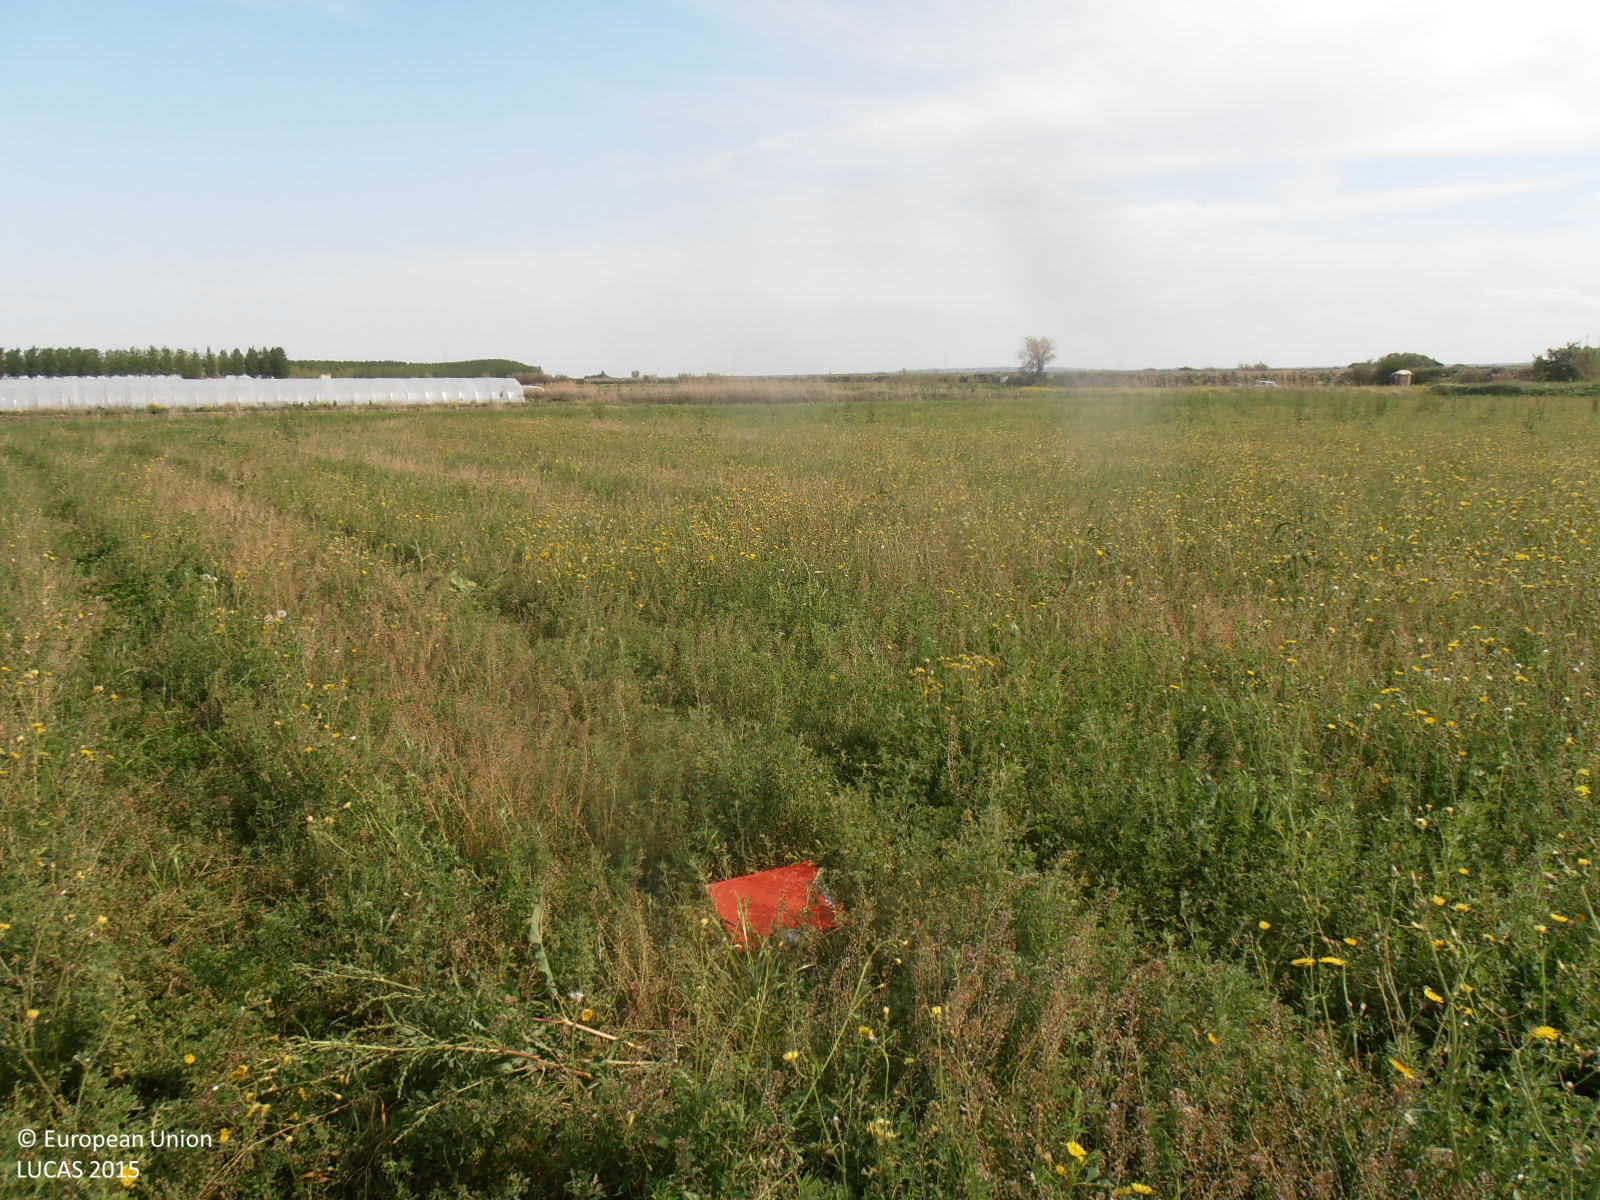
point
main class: Cropland
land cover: Lucerne
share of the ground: > 75 %
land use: Agriculture (excluding fallow land and kitchen gardens)
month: April
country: ES
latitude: 41.6390
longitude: -0.7896
